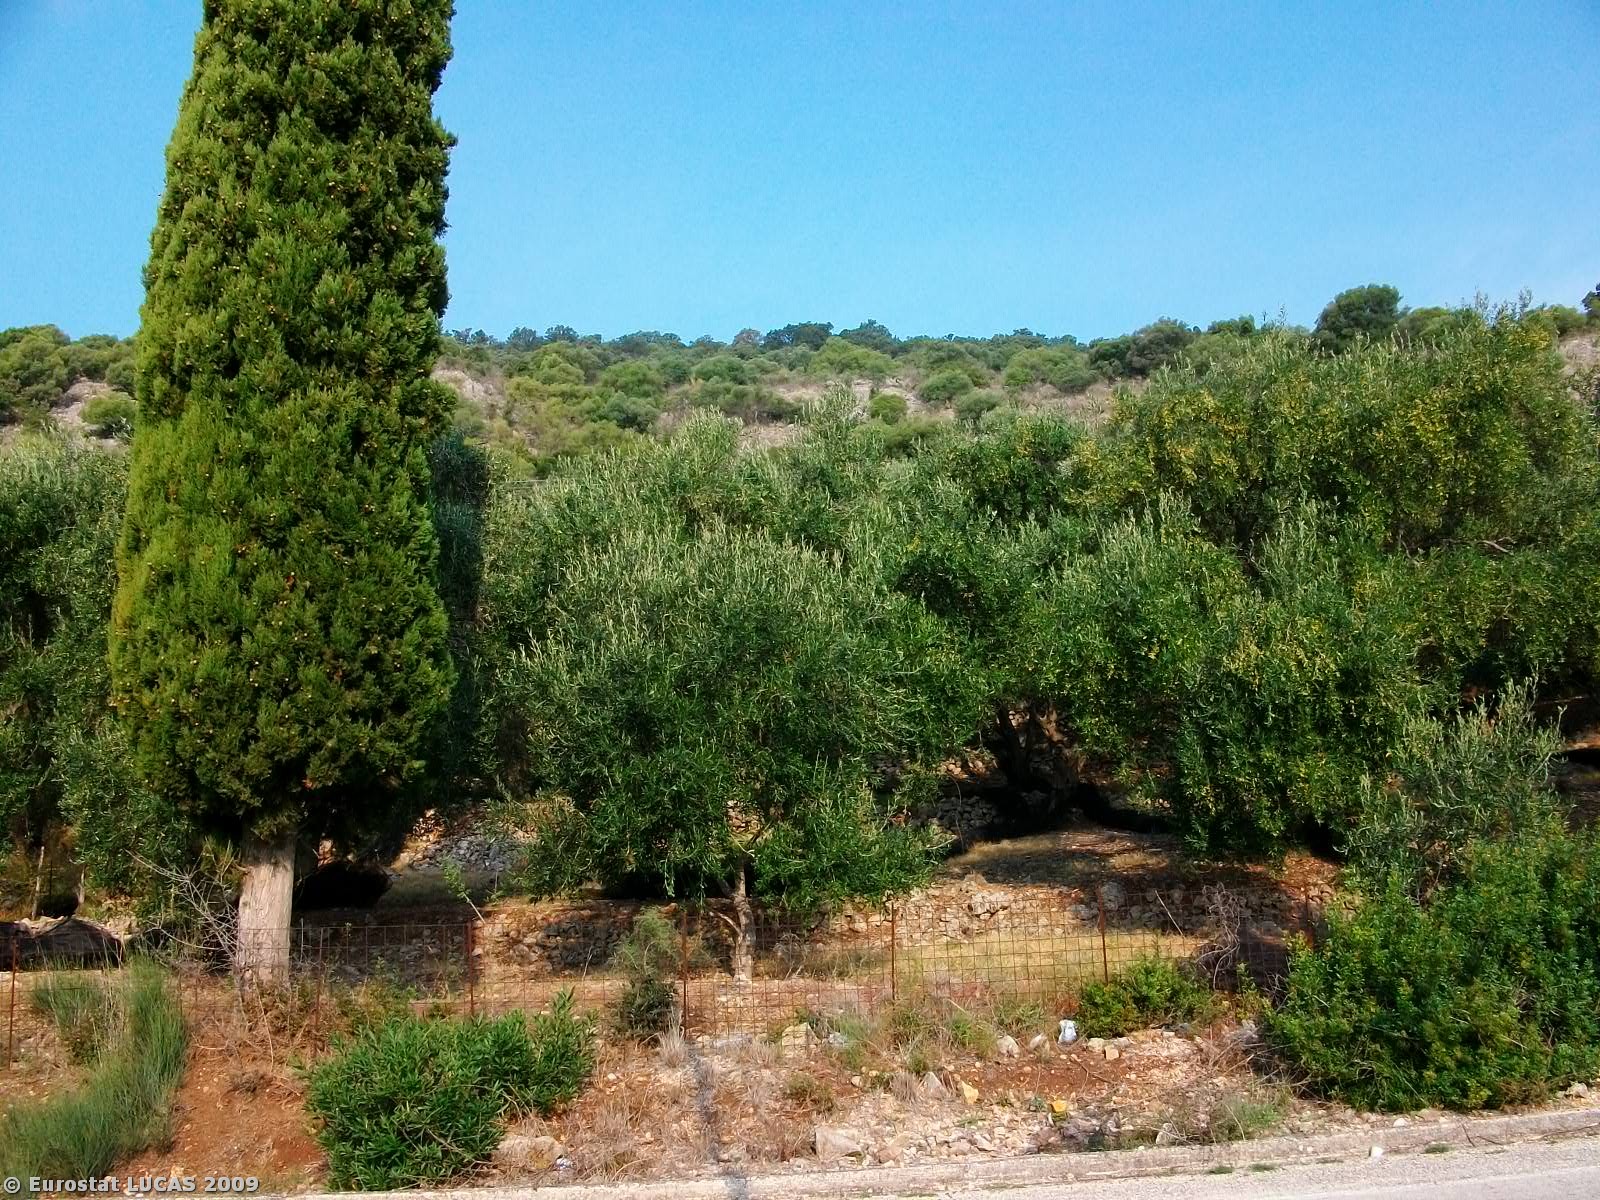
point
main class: Shrubland
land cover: Shrubland without tree cover
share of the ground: > 75 %
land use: Agriculture (excluding fallow land and kitchen gardens)
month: October
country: GR
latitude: 39.2867
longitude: 20.4647
